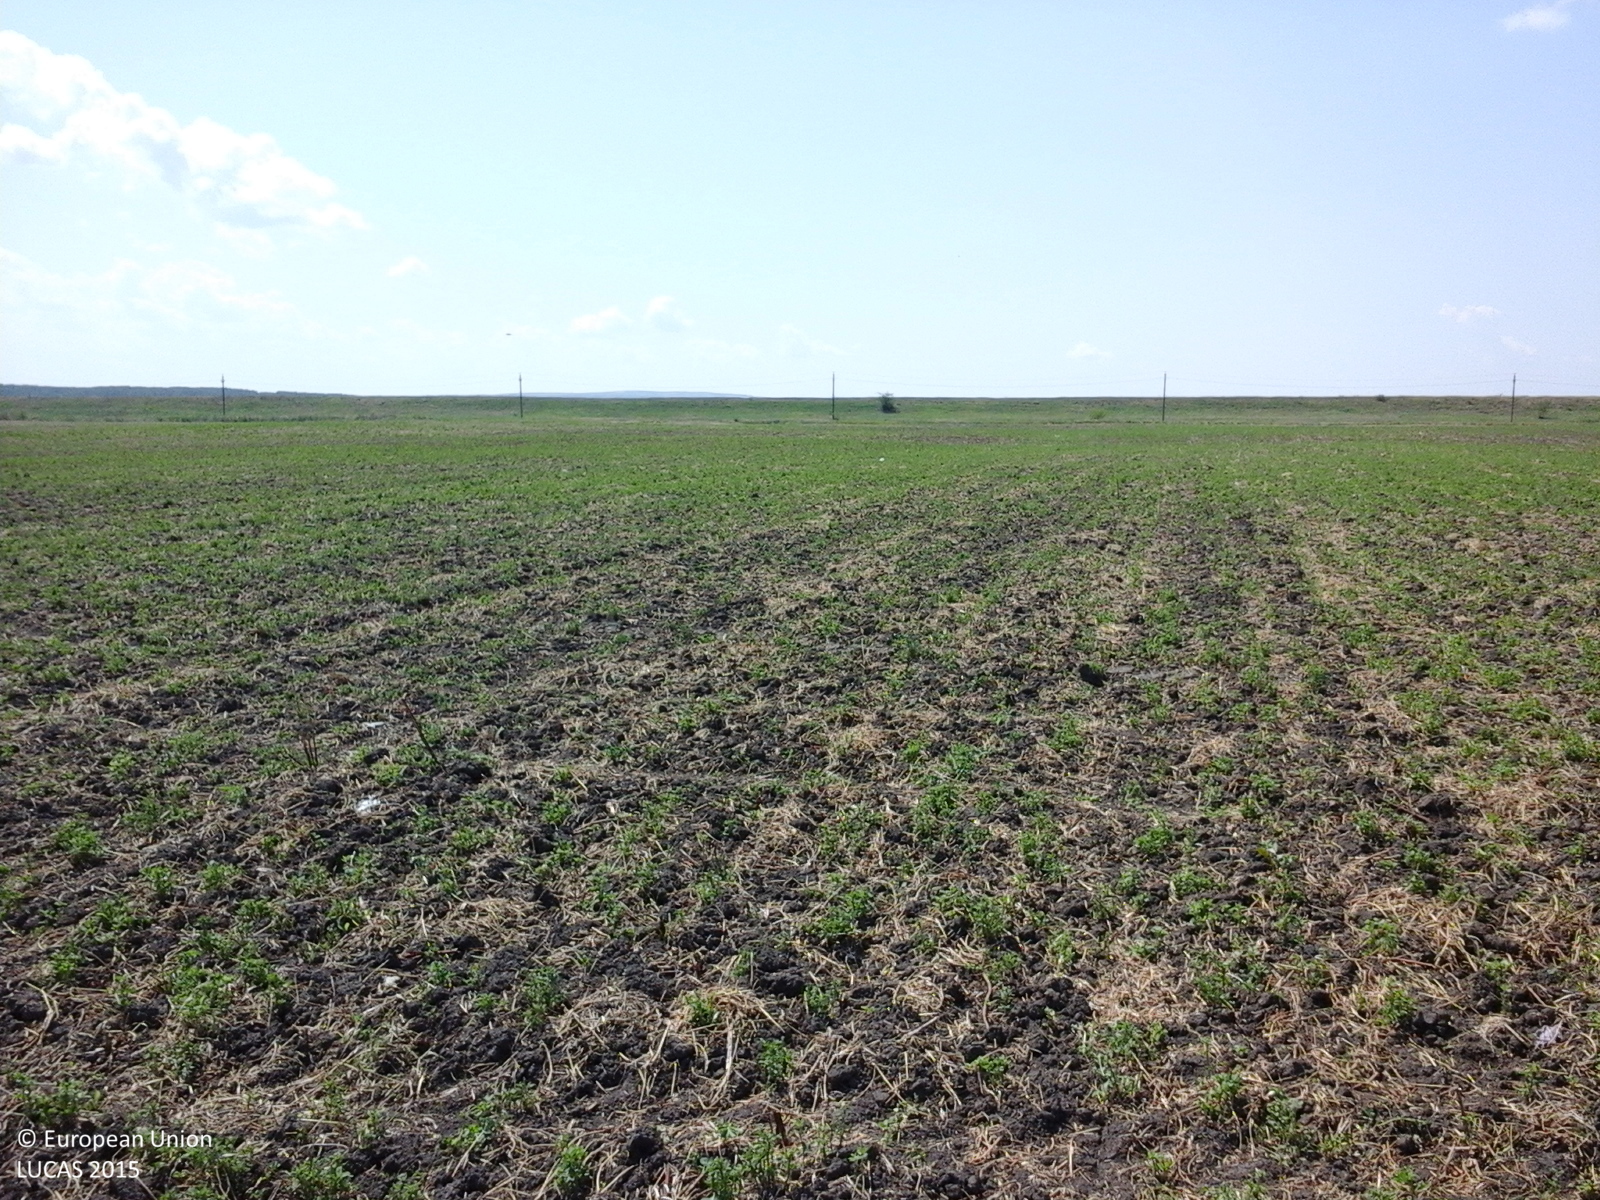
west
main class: Cropland
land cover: Clovers
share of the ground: 10 - 25 %
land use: Agriculture (excluding fallow land and kitchen gardens)
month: July
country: RO
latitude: 43.7266
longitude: 24.1221
